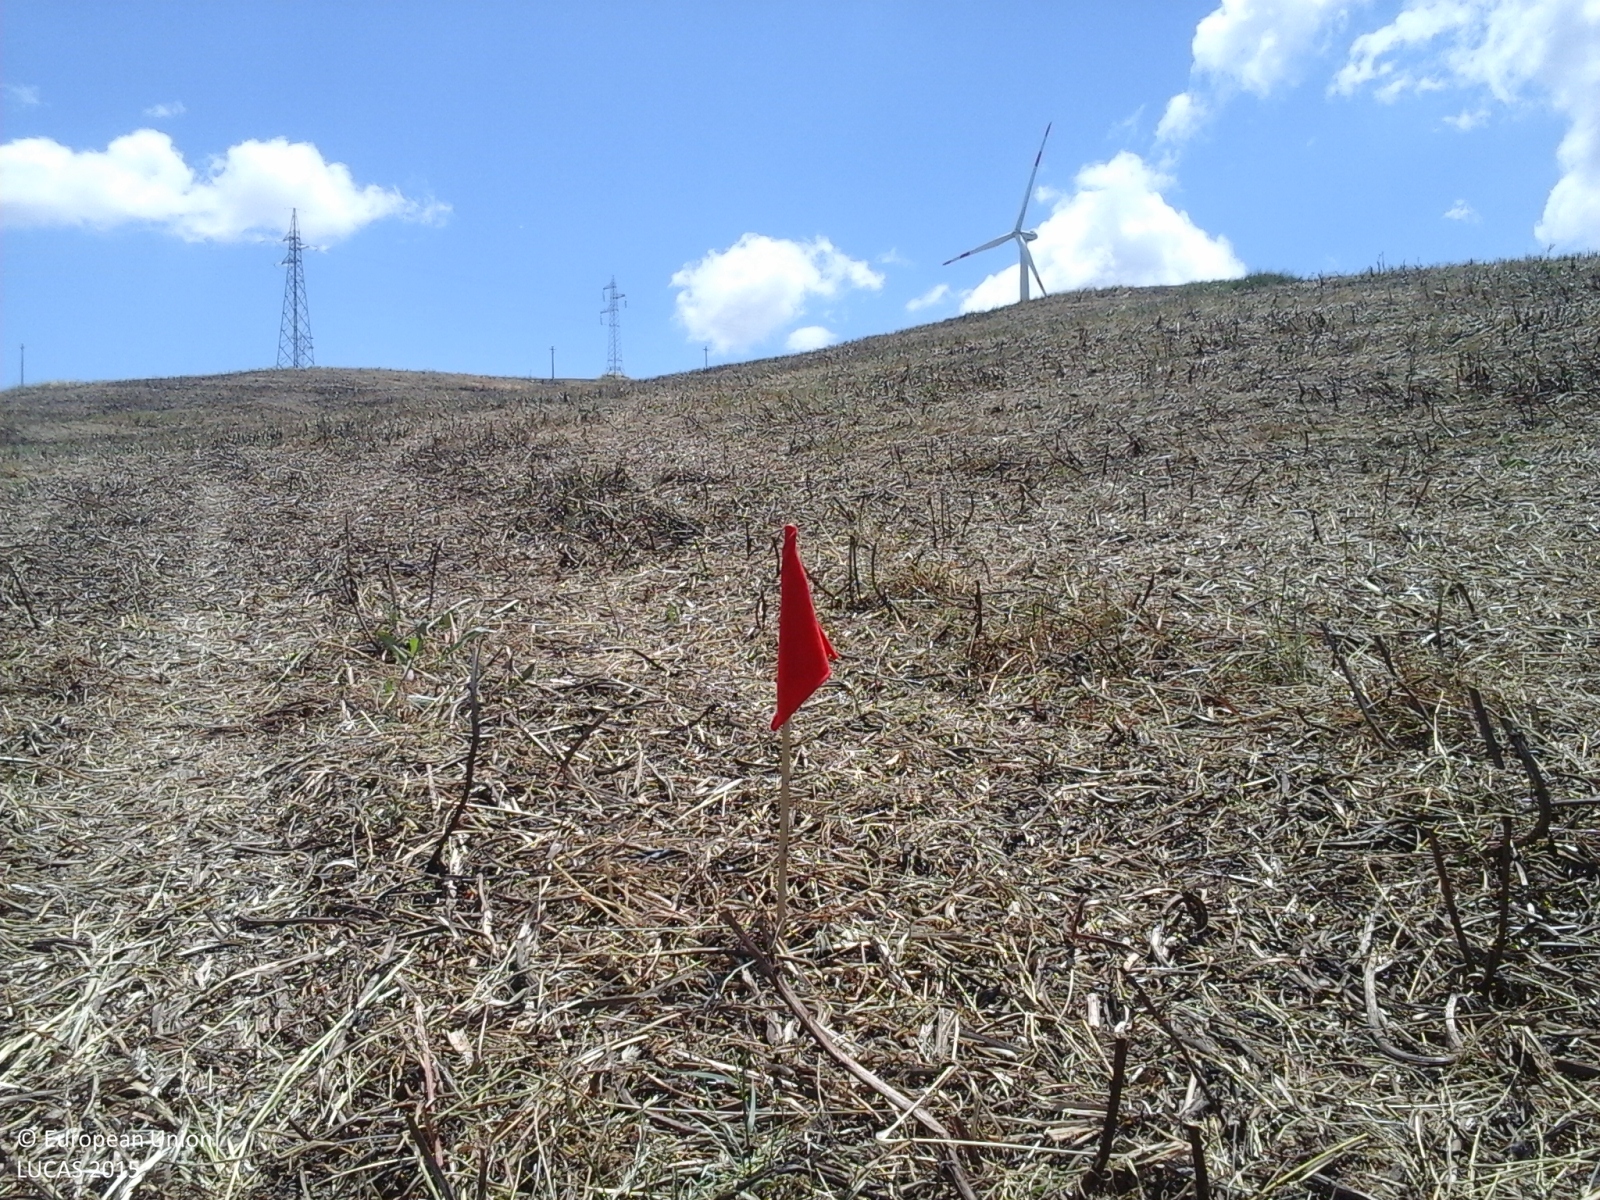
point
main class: Cropland
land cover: Dry pulses
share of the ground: > 75 %
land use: Agriculture (excluding fallow land and kitchen gardens)
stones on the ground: < 10 %
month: June
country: IT
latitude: 37.7894
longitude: 13.5737
